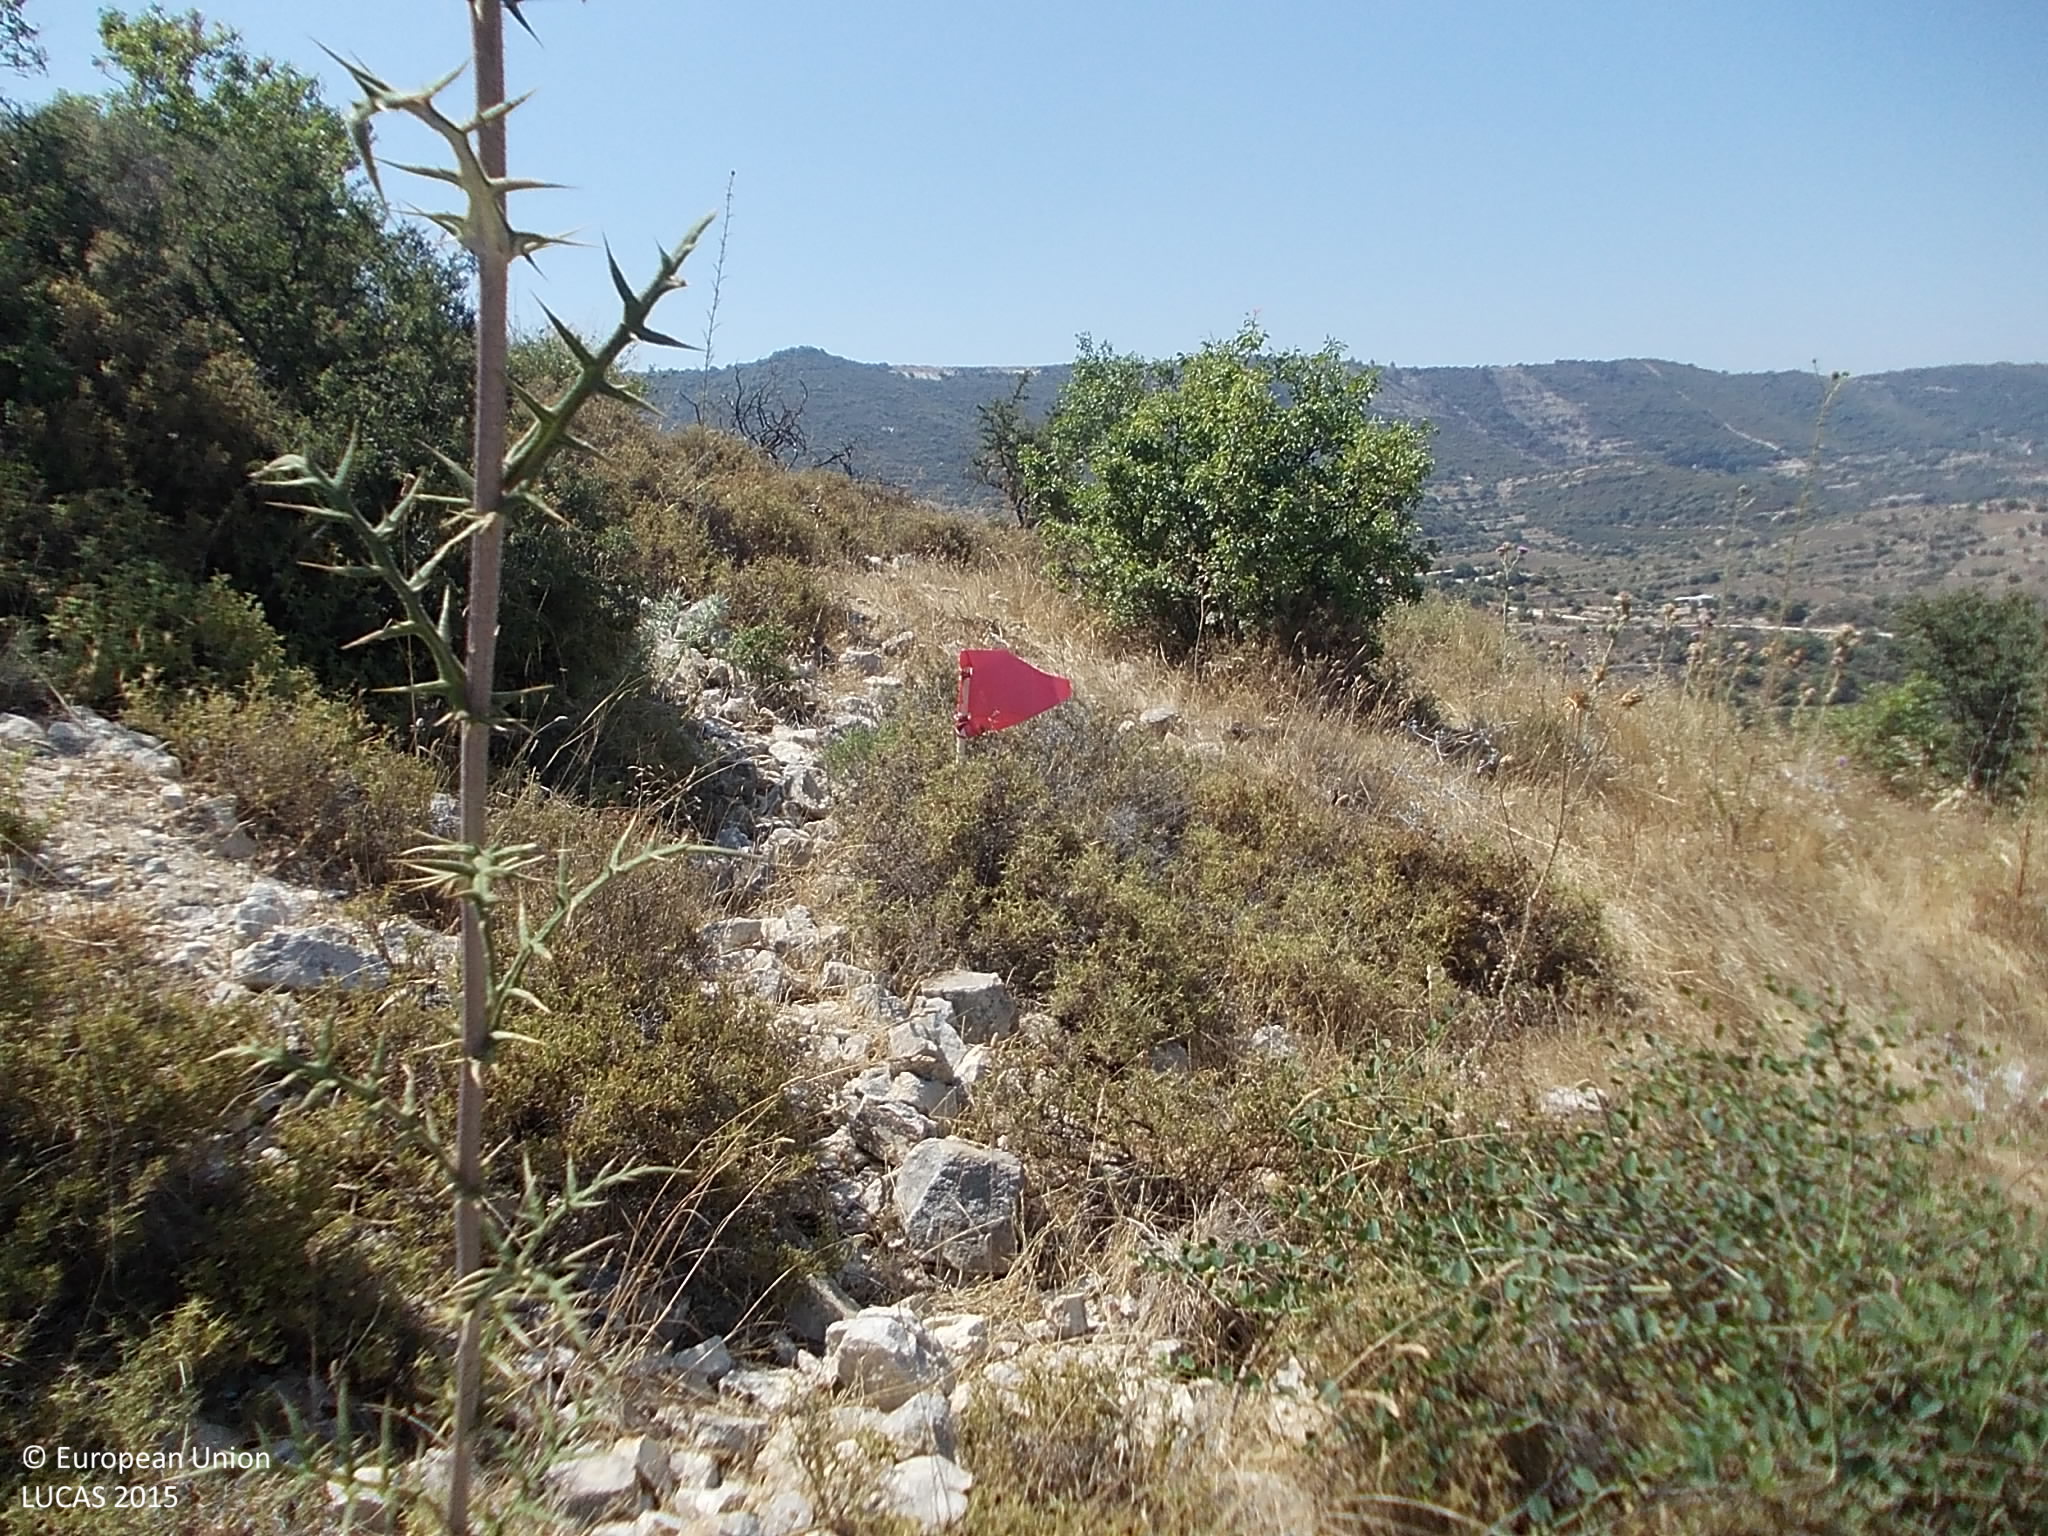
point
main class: Shrubland
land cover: Shrubland without tree cover
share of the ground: 50 - 75 %
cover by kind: shrubs 70 %, herbaceous plants 20 %, unconsolidated bare surface 10 %
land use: Semi-natural and natural areas not in use
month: July
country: CY
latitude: 34.7891
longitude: 32.7242
